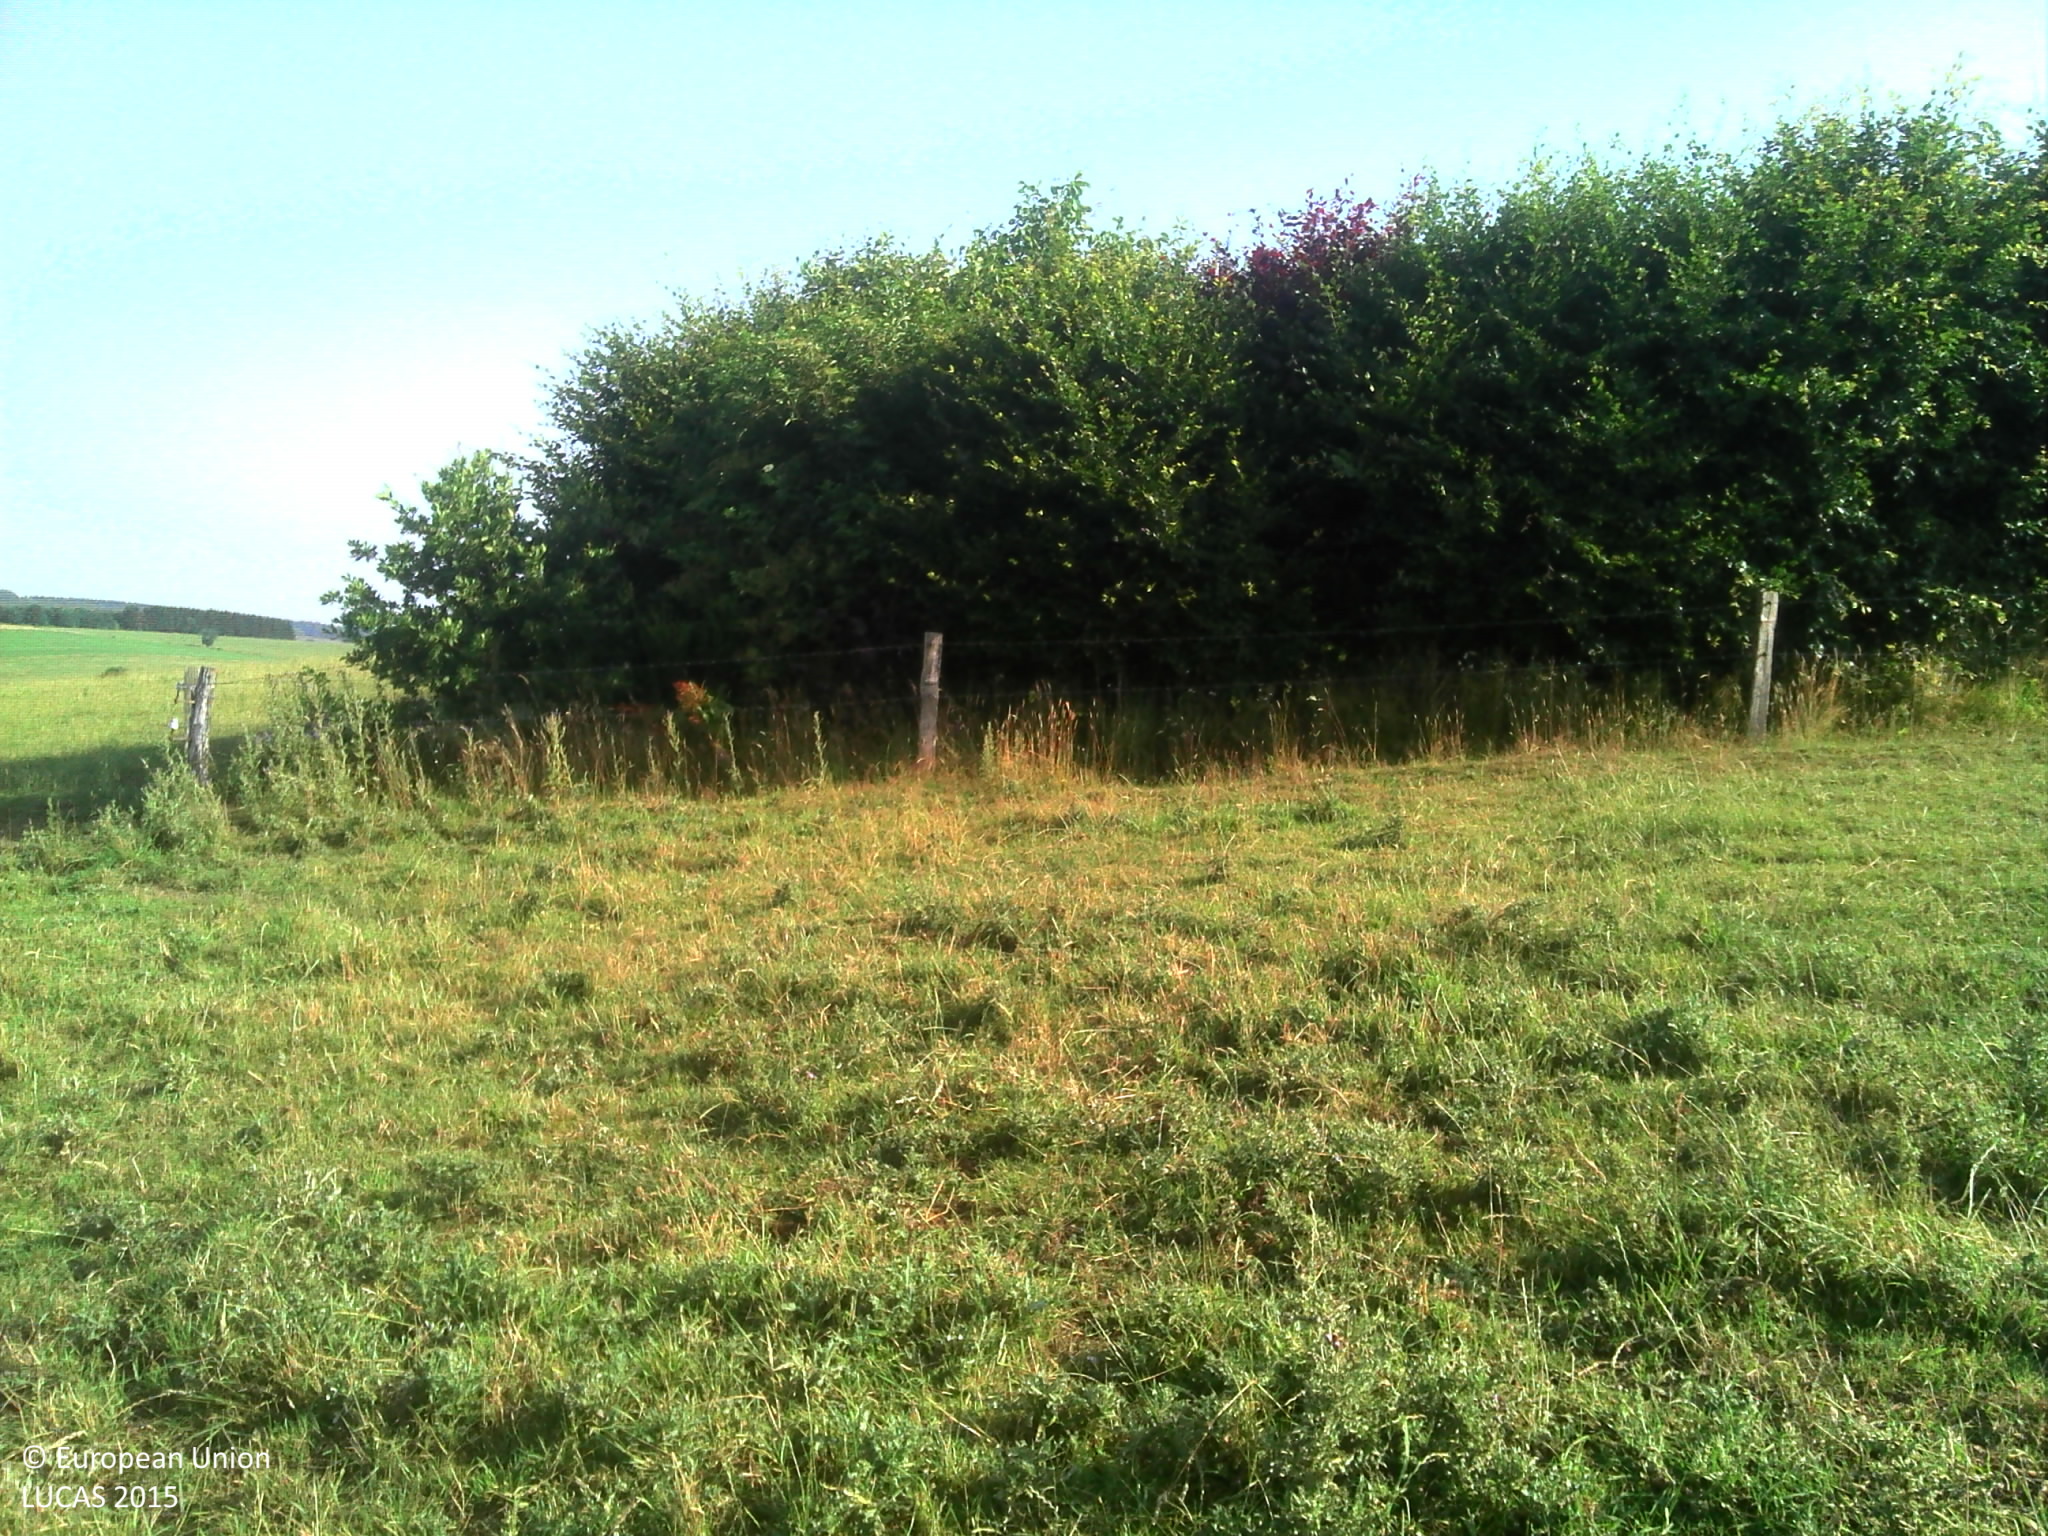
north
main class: Grassland
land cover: Grassland without tree/shrub cover
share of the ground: > 75 %
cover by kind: herbaceous plants 100 %
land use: Agriculture (excluding fallow land and kitchen gardens)
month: July
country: BE
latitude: 49.9545
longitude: 5.5802
